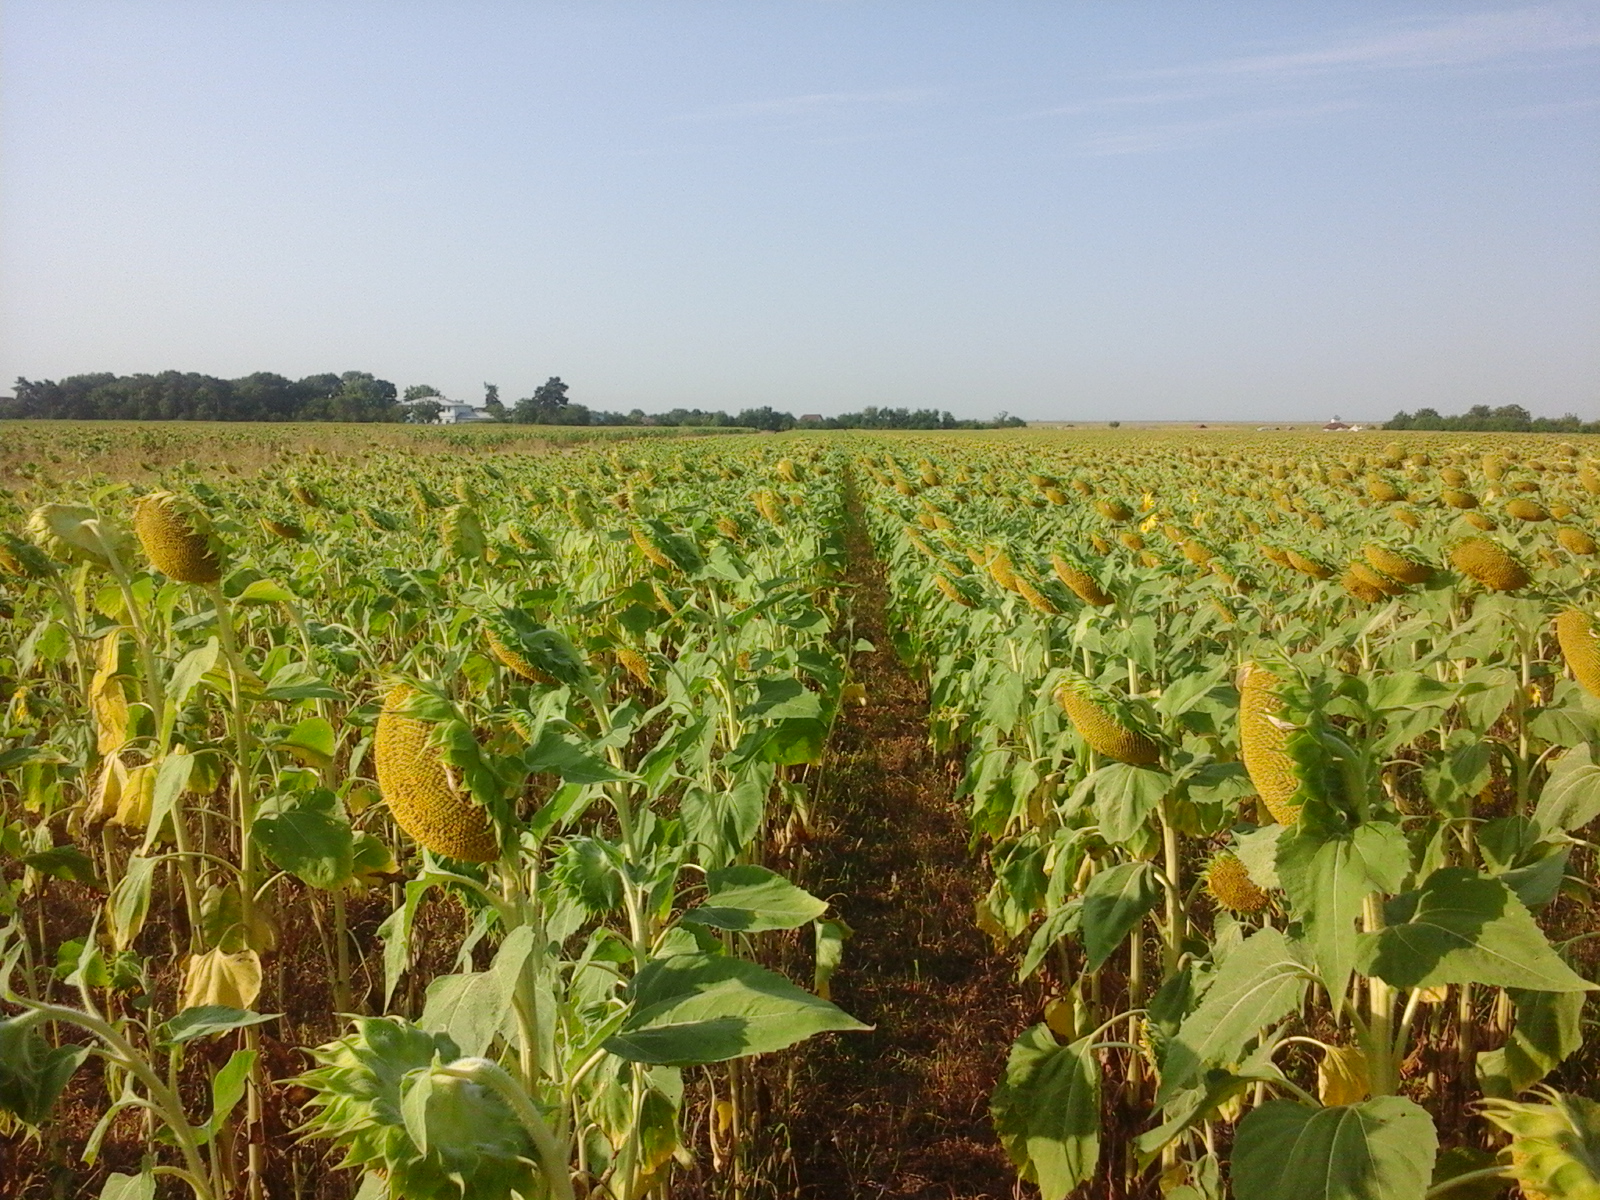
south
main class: Cropland
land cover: Sunflower
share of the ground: > 75 %
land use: Agriculture (excluding fallow land and kitchen gardens)
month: August
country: RO
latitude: 44.1681
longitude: 23.6981
